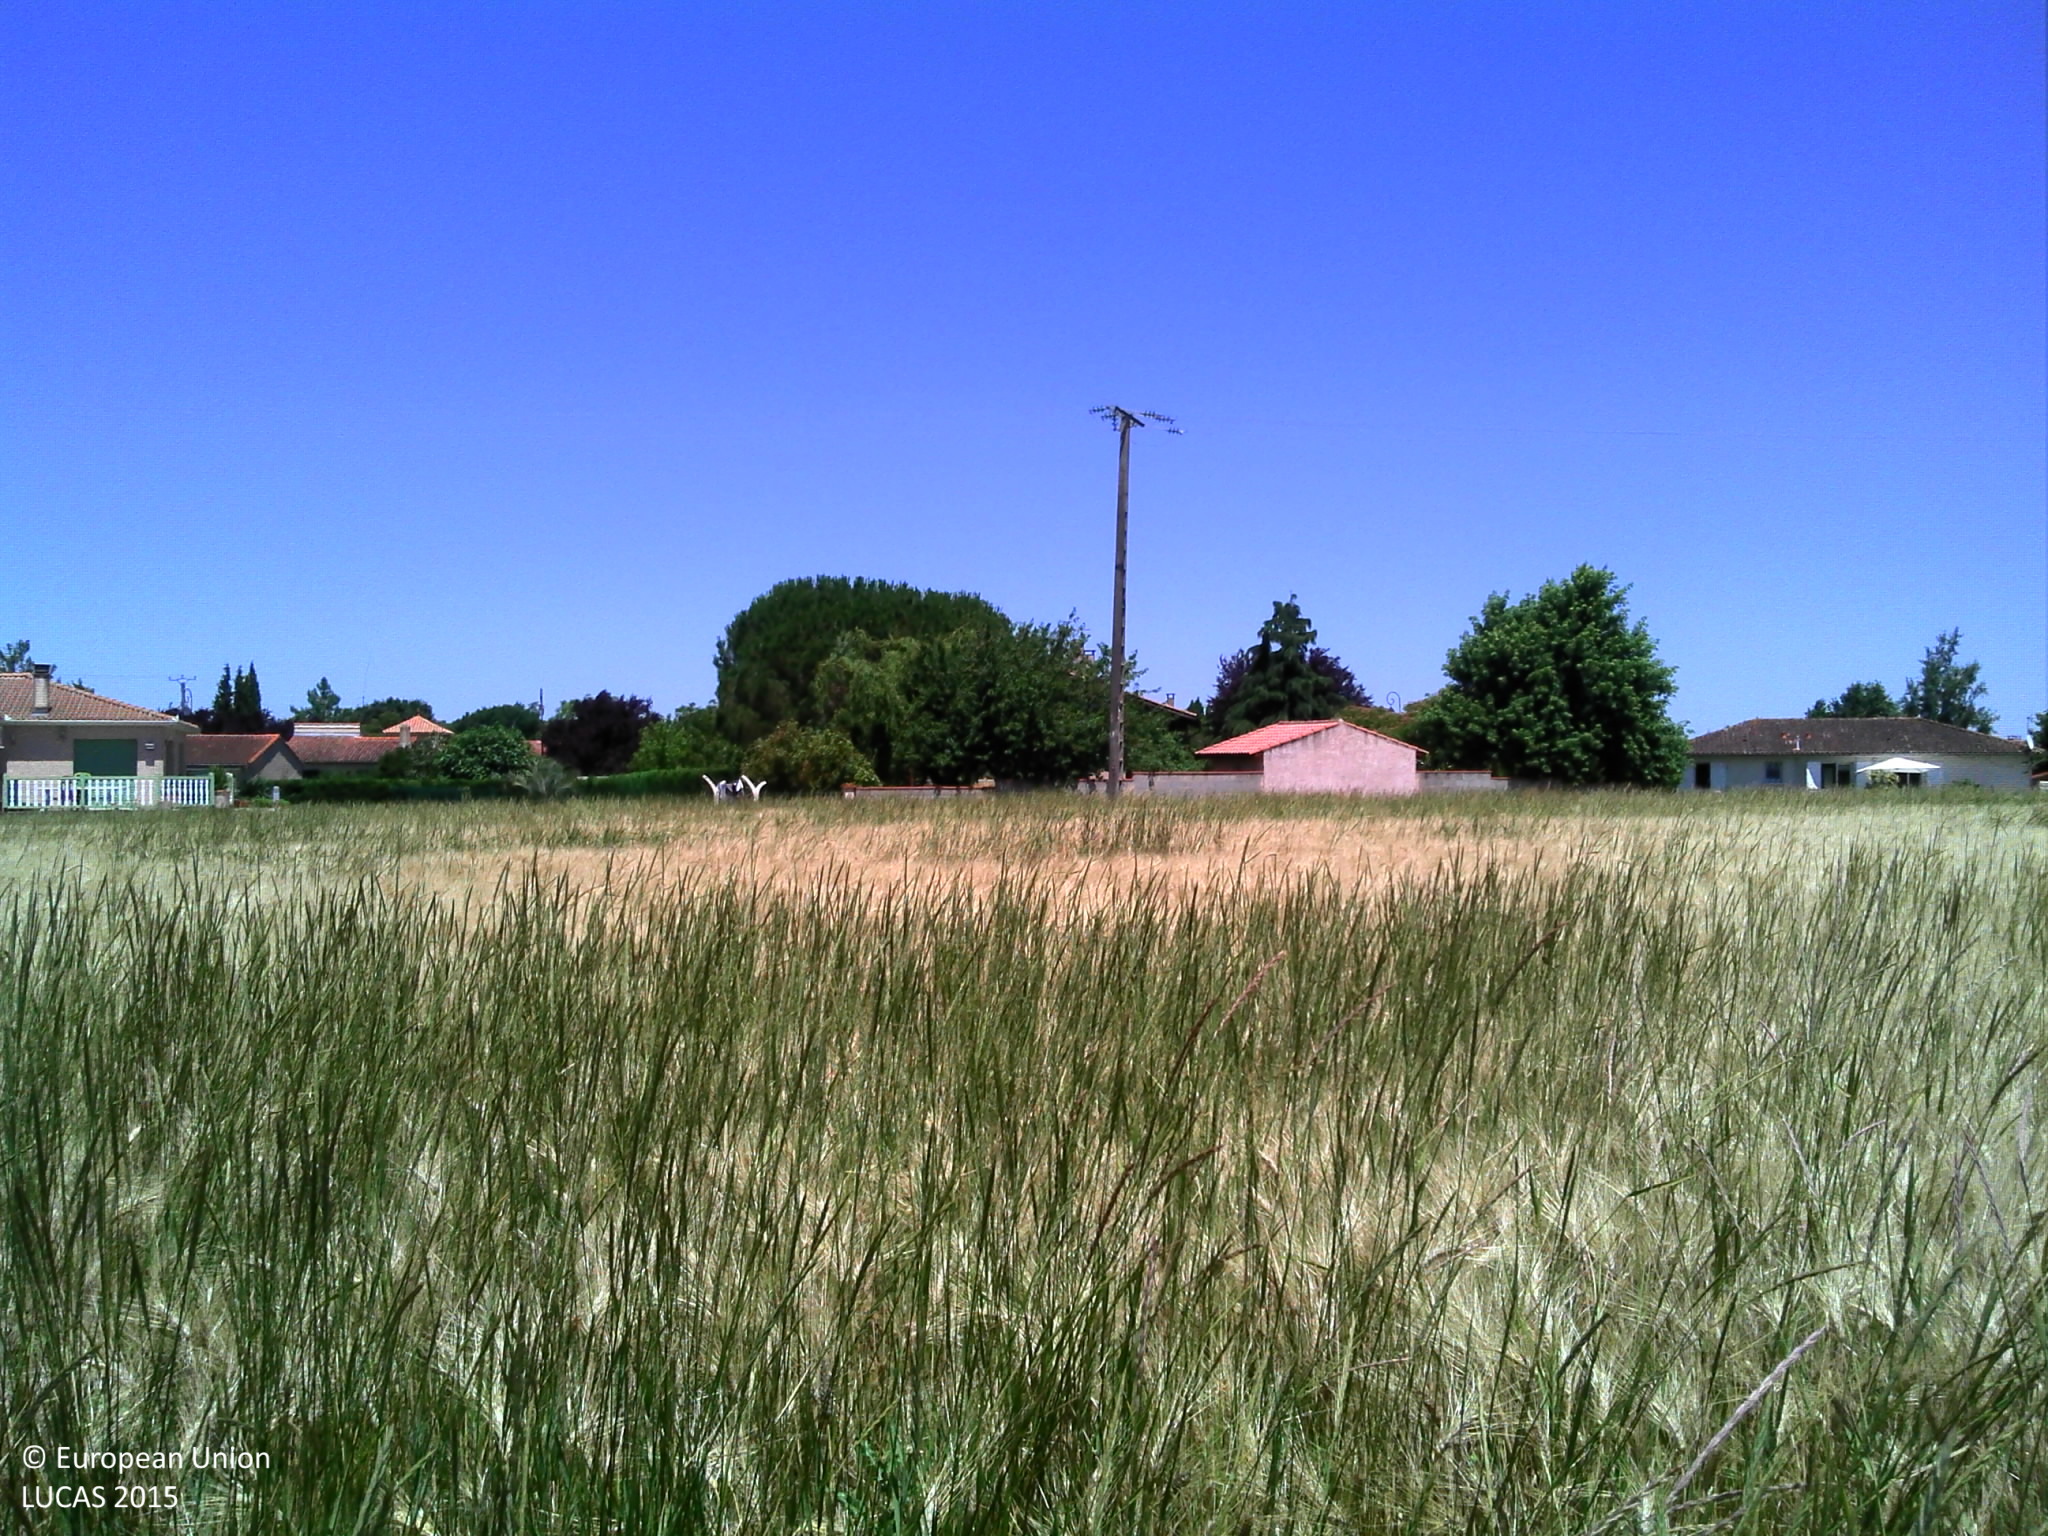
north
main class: Cropland
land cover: Barley
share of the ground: > 75 %
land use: Agriculture (excluding fallow land and kitchen gardens)
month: June
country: FR
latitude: 43.7127
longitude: 1.3011
